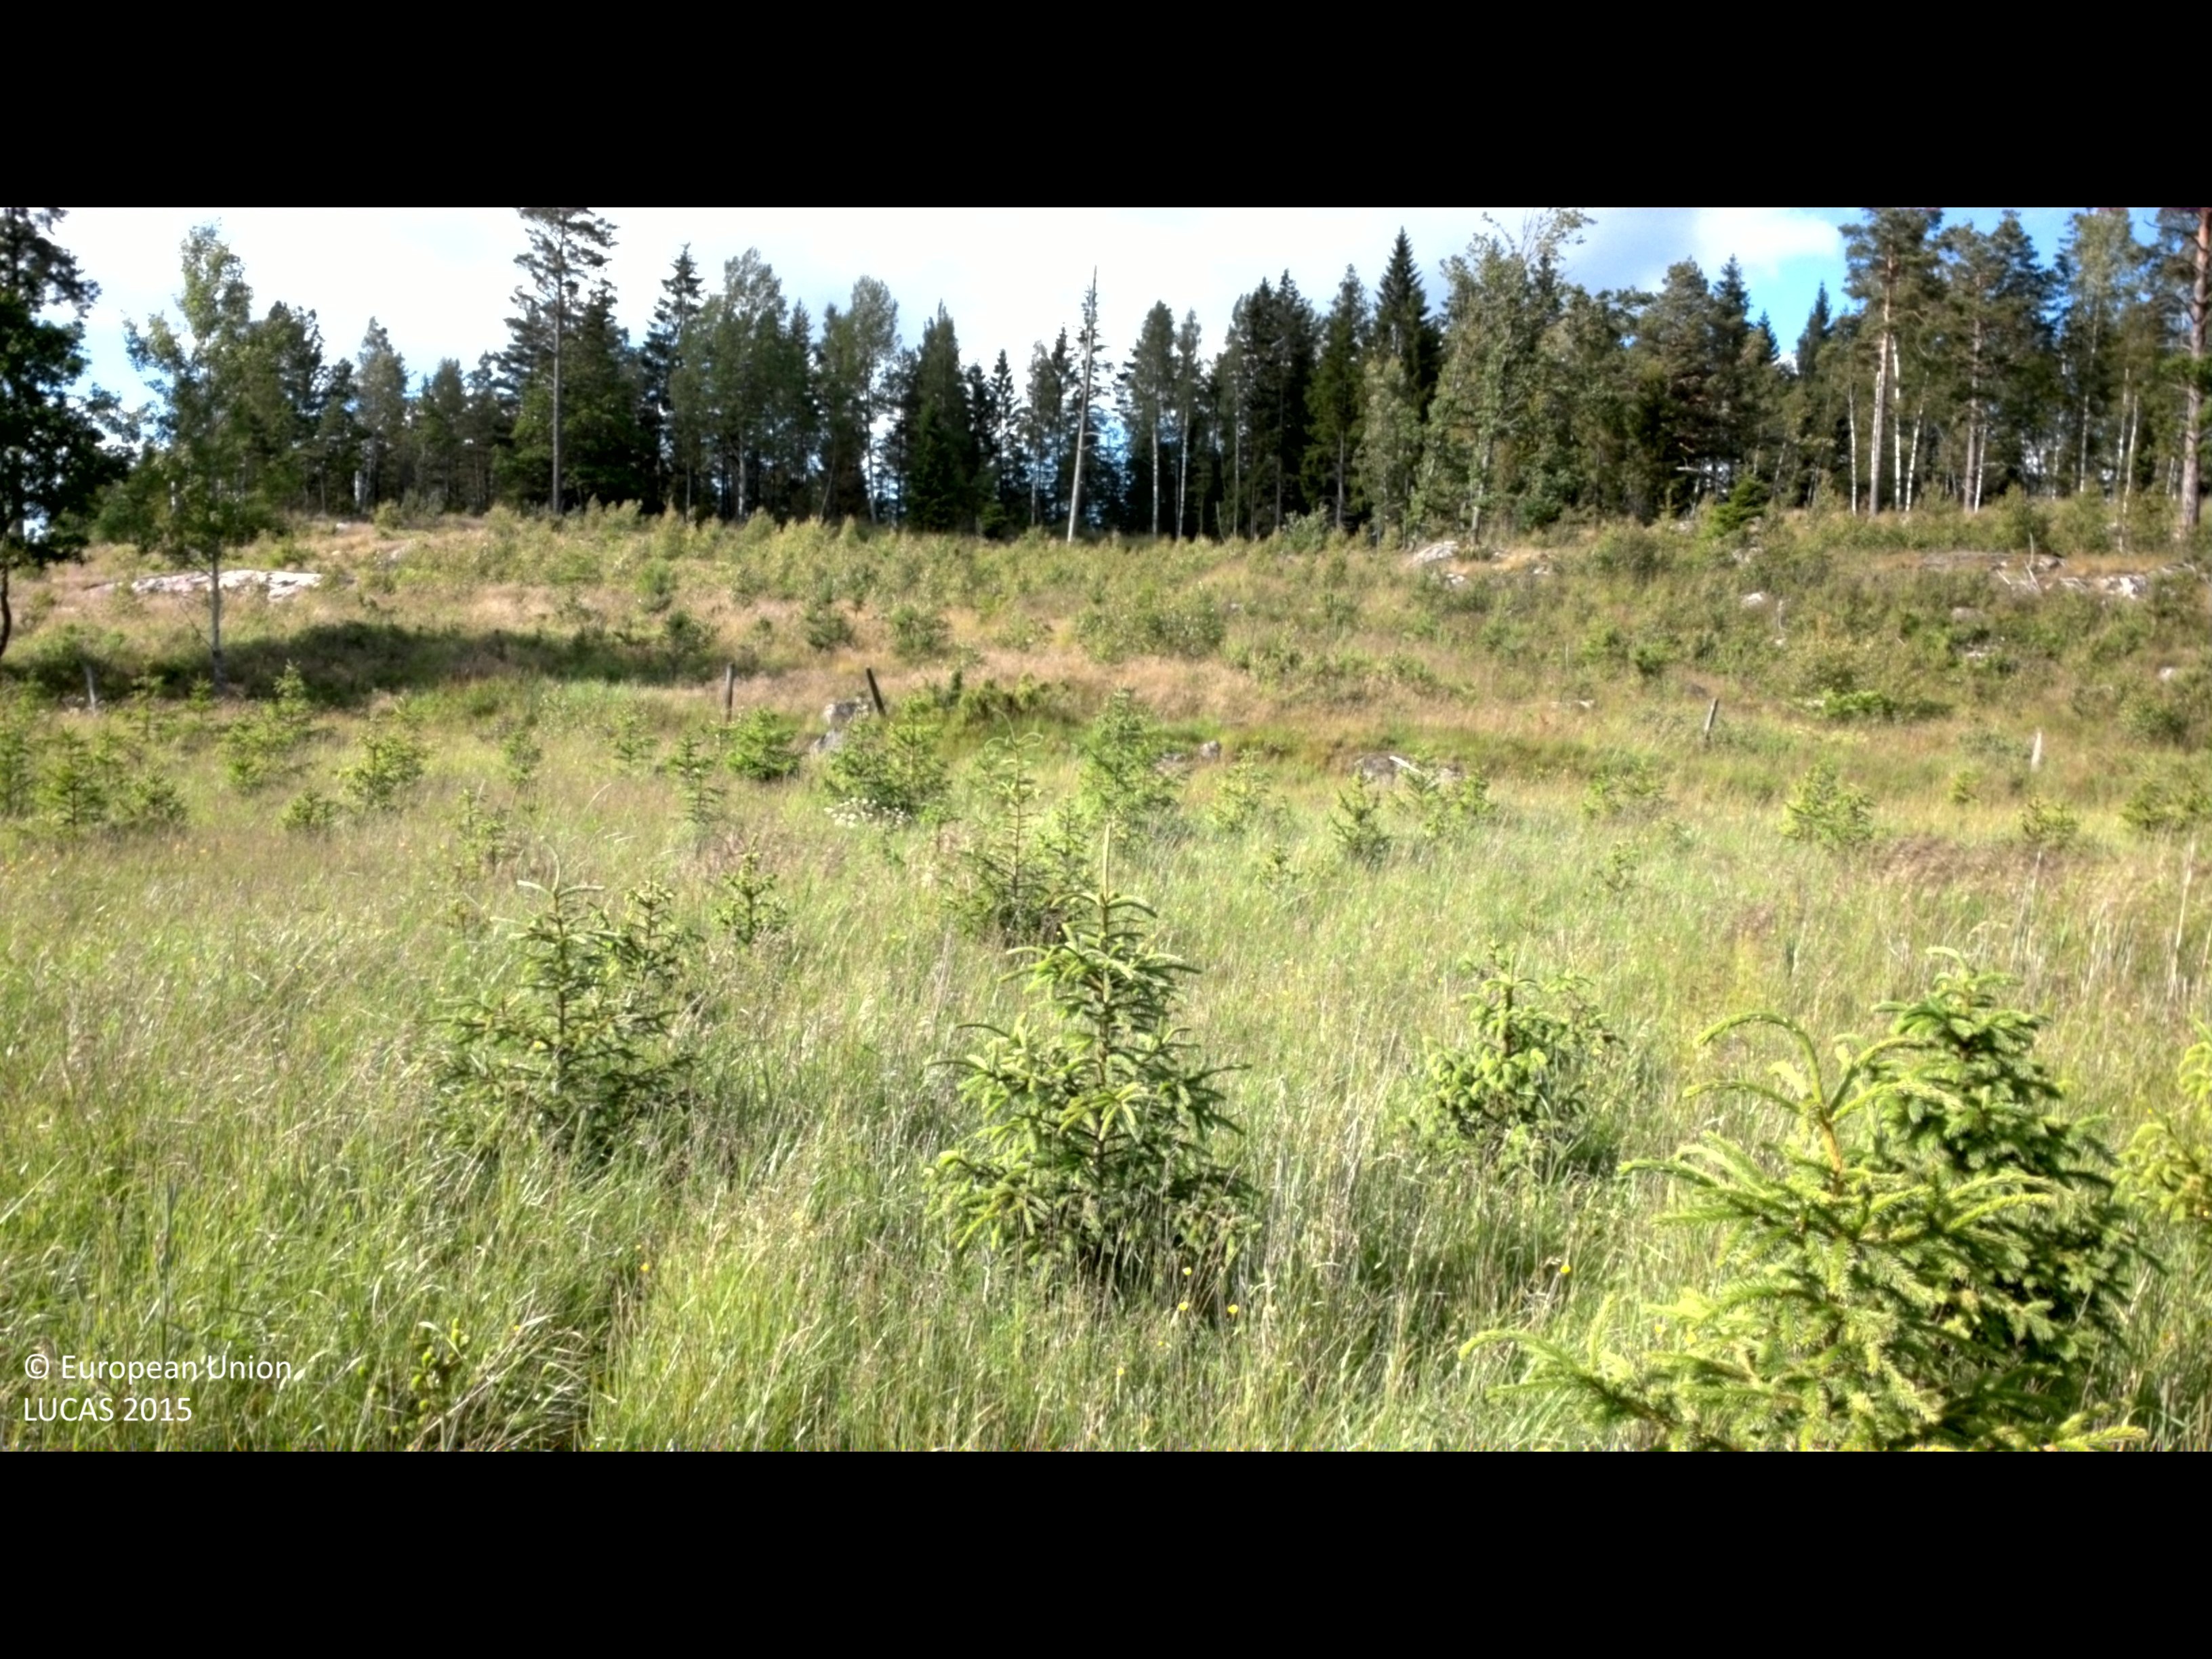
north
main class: Woodland
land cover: Spruce dominated coniferous woodland
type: boreal forest
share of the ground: < 10 %
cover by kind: herbaceous plants 90 %, coniferous forest trees 10 %
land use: Forestry
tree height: < 5 m
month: June
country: SE
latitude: 58.0936
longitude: 16.5965
